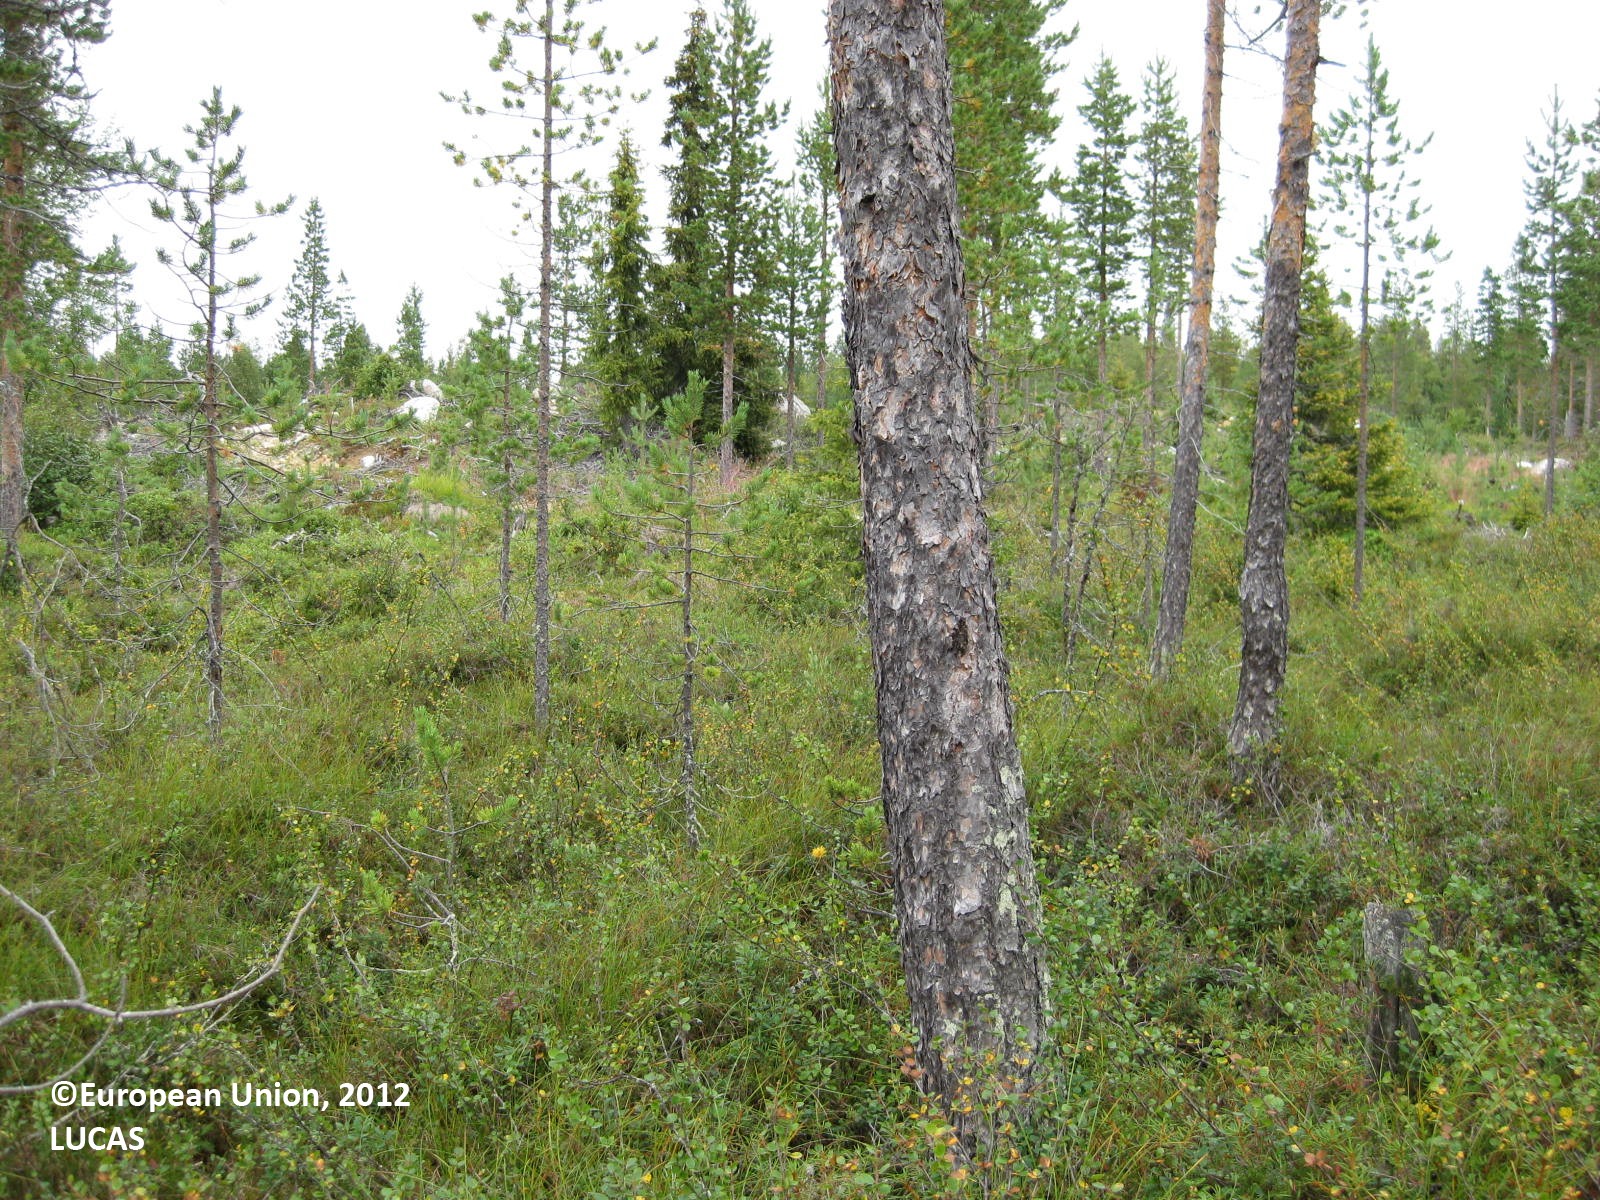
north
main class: Woodland
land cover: Pine dominated coniferous woodland
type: boreal forest
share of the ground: 50 - 75 %
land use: Forestry
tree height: > 5 m
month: August
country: FI
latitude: 66.4643
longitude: 29.0855
